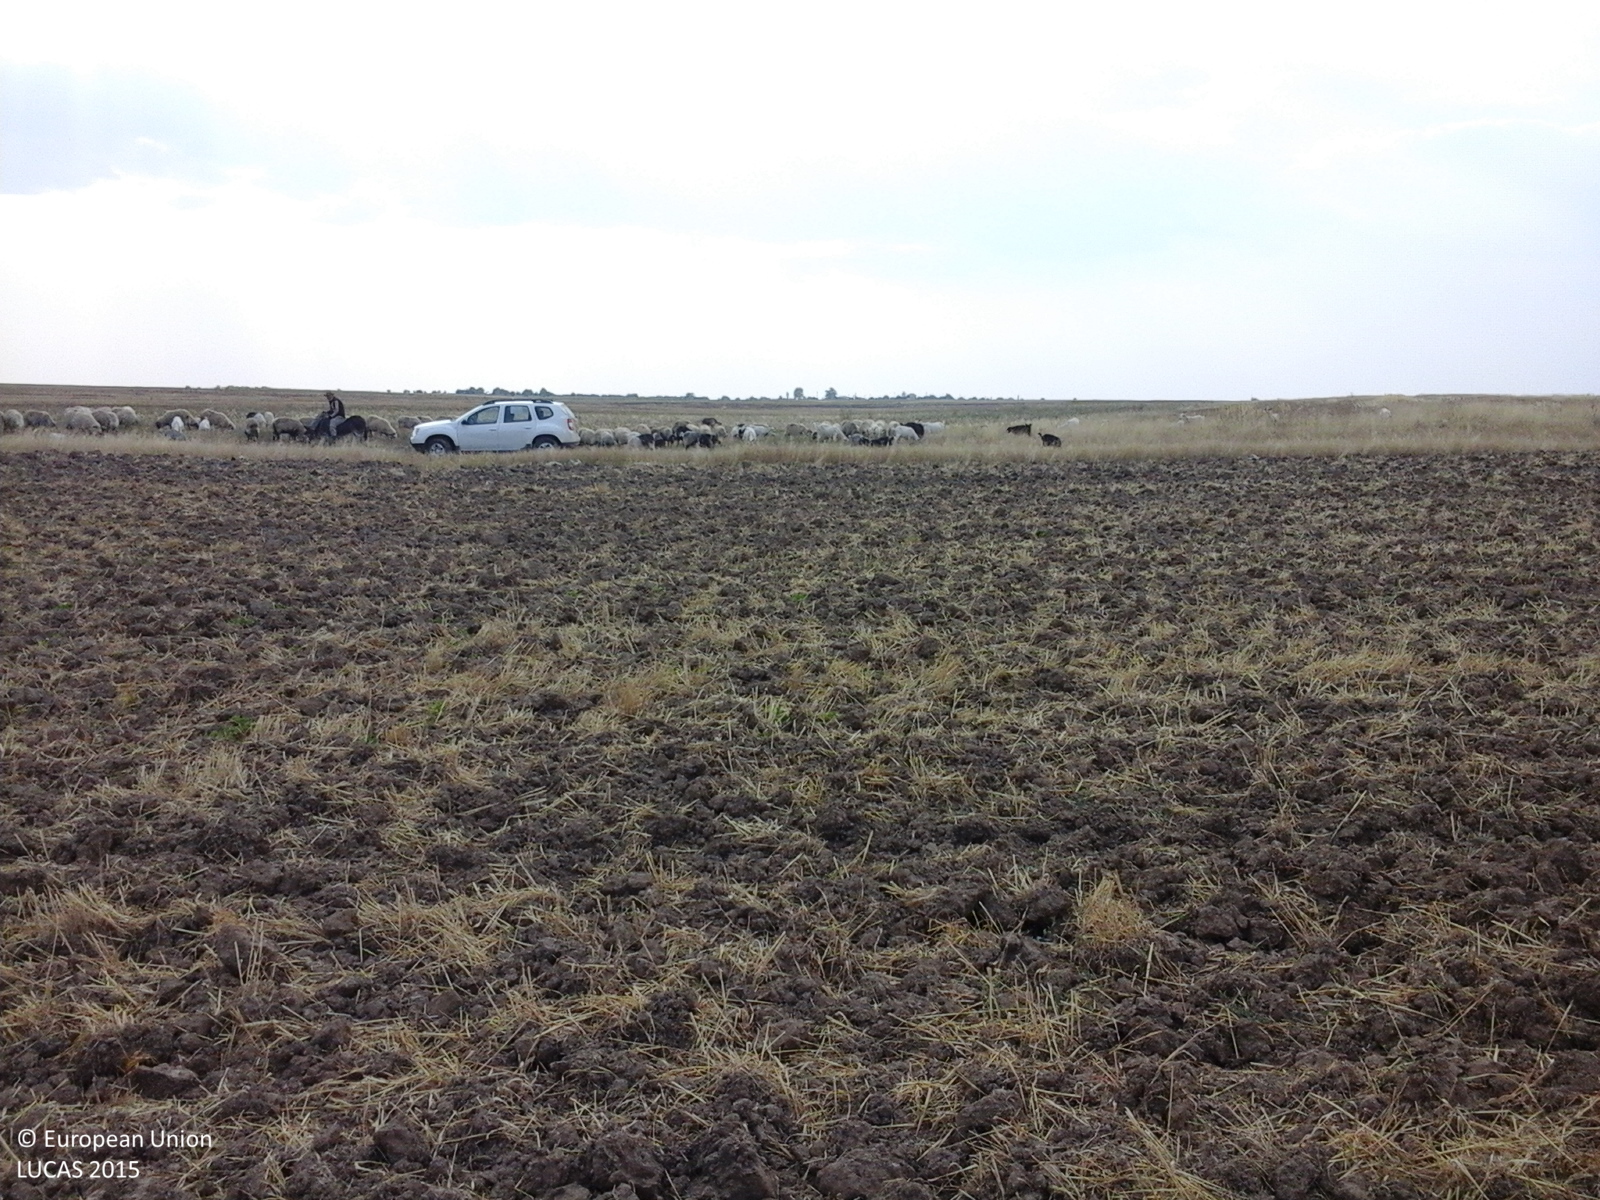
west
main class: Cropland
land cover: Durum wheat
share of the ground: 10 - 25 %
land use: Agriculture (excluding fallow land and kitchen gardens)
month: August
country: RO
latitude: 44.2808
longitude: 23.1144
